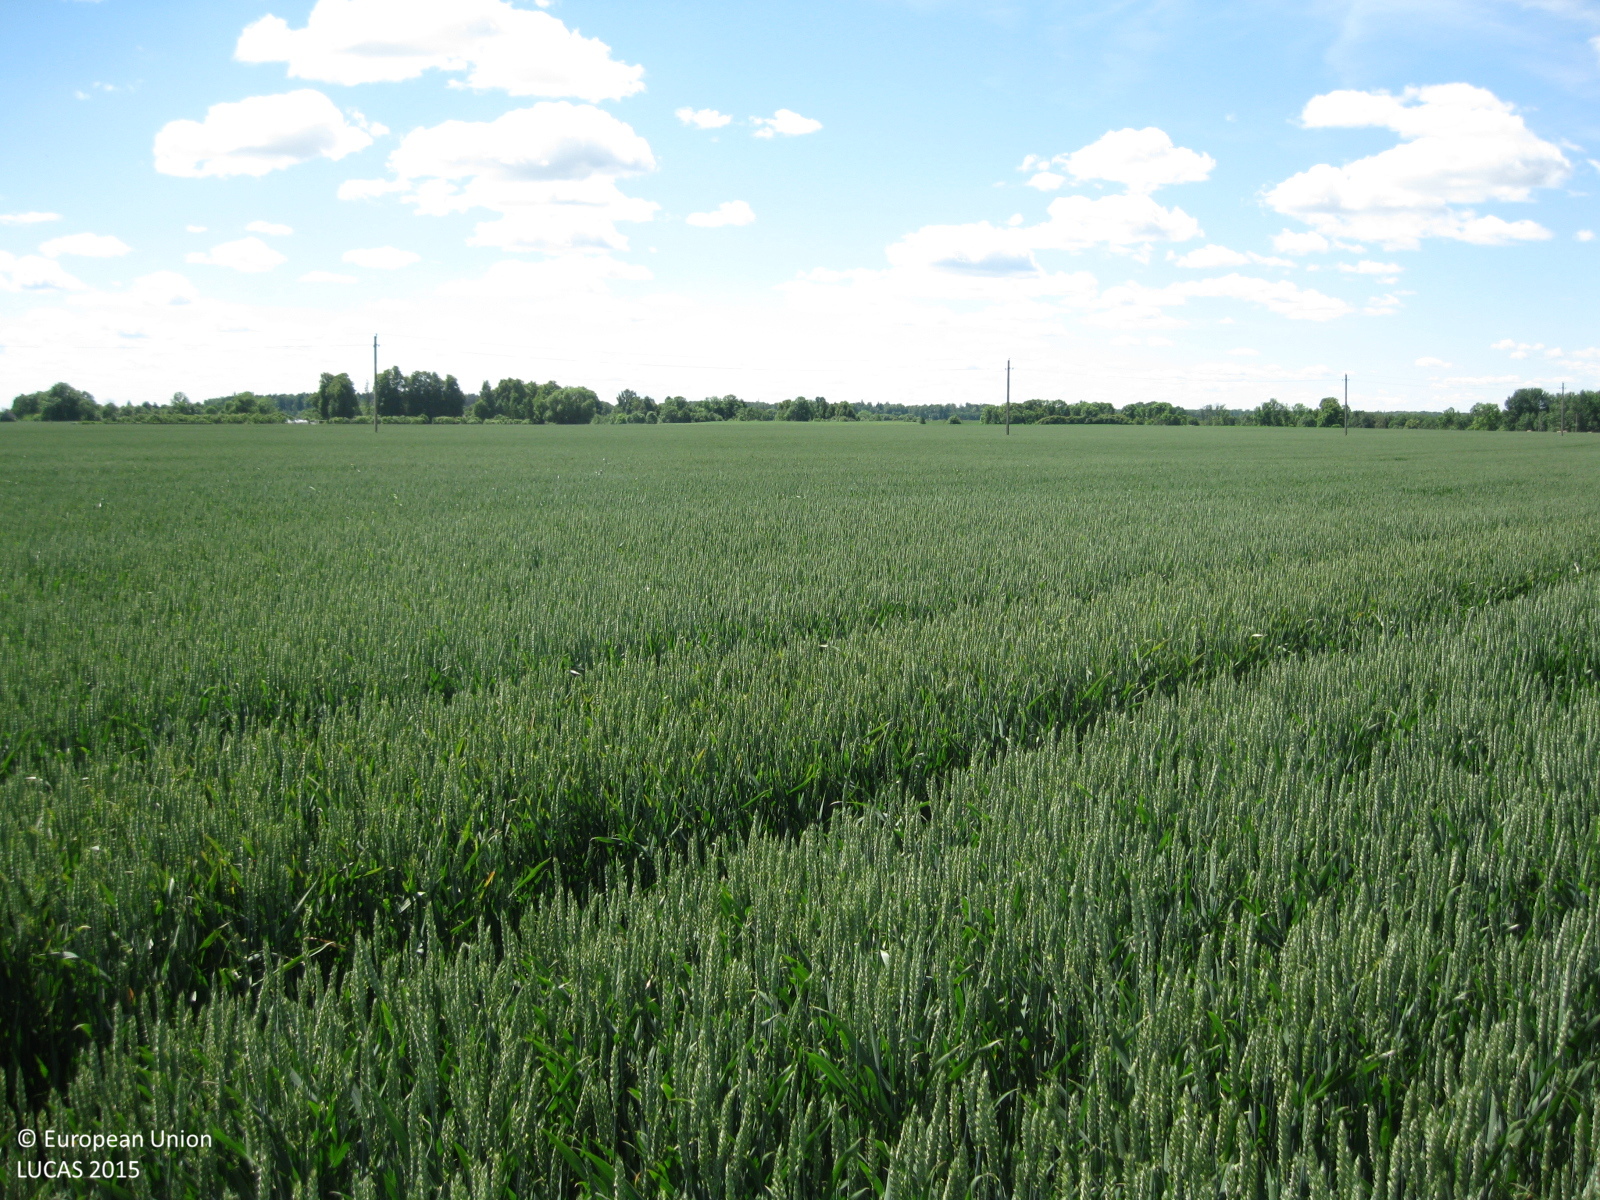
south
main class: Cropland
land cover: Common wheat
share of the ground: > 75 %
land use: Agriculture (excluding fallow land and kitchen gardens)
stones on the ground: < 10 %
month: June
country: LT
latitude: 55.3157
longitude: 23.9068
